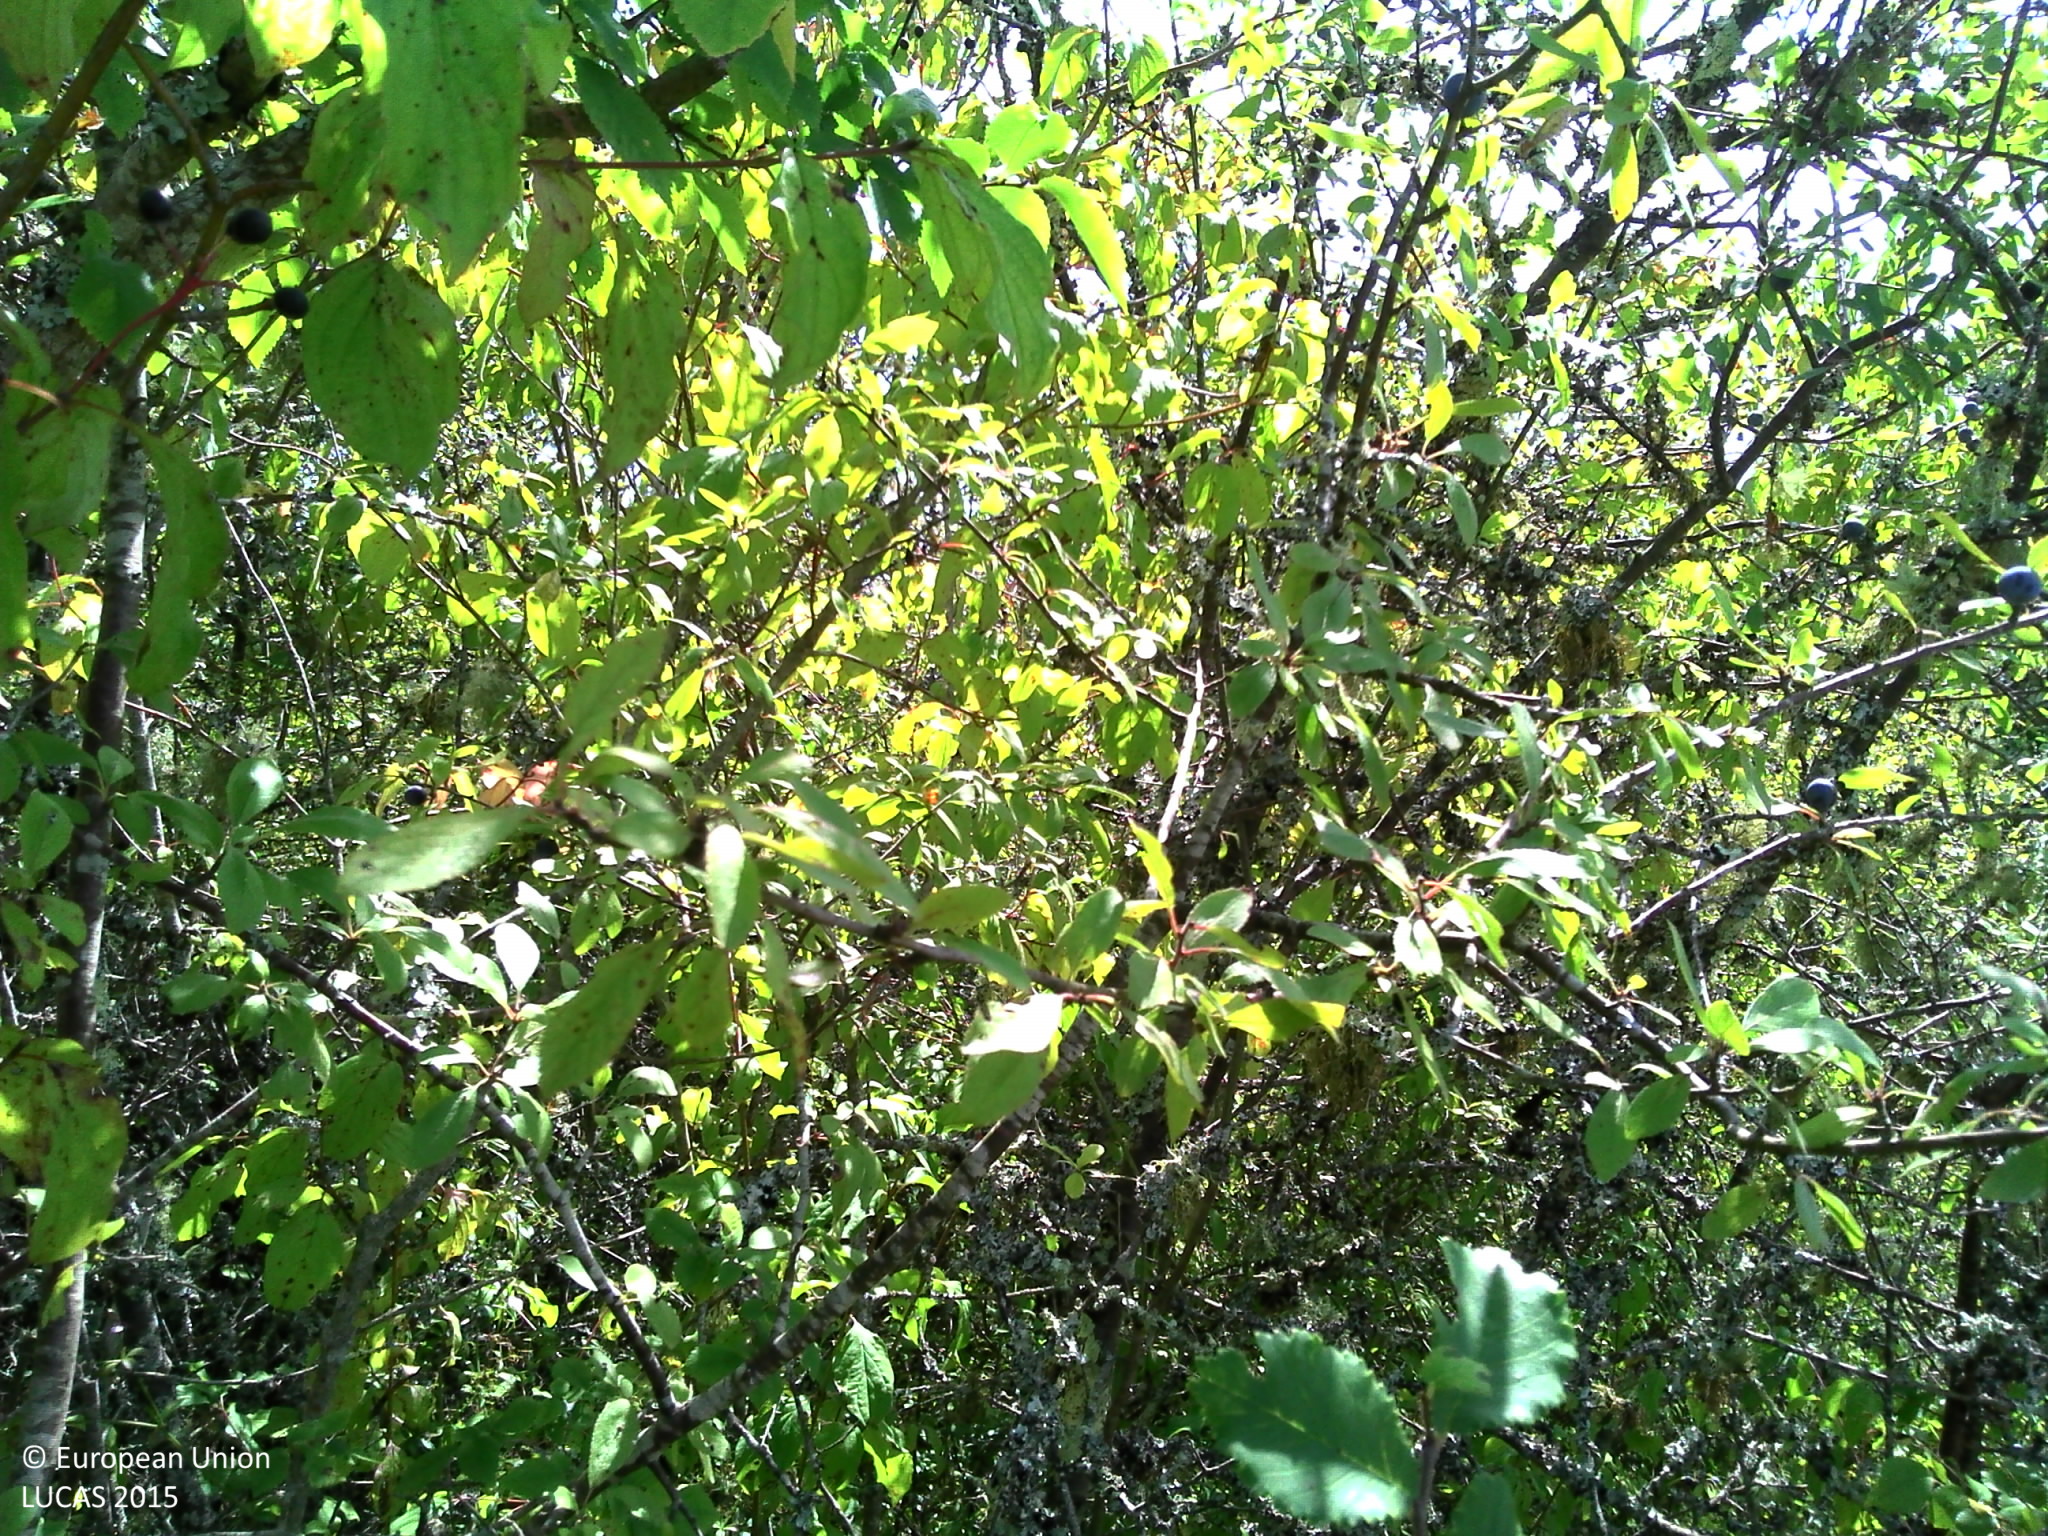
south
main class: Shrubland
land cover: Shrubland with sparse tree cover
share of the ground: > 75 %
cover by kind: shrubs 45 %, herbaceous plants 40 %, lichens and mosses 10 %, broadleaved forest trees 5 %
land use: Forestry
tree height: < 5 m
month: August
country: FR
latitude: 45.2025
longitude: 0.5041
